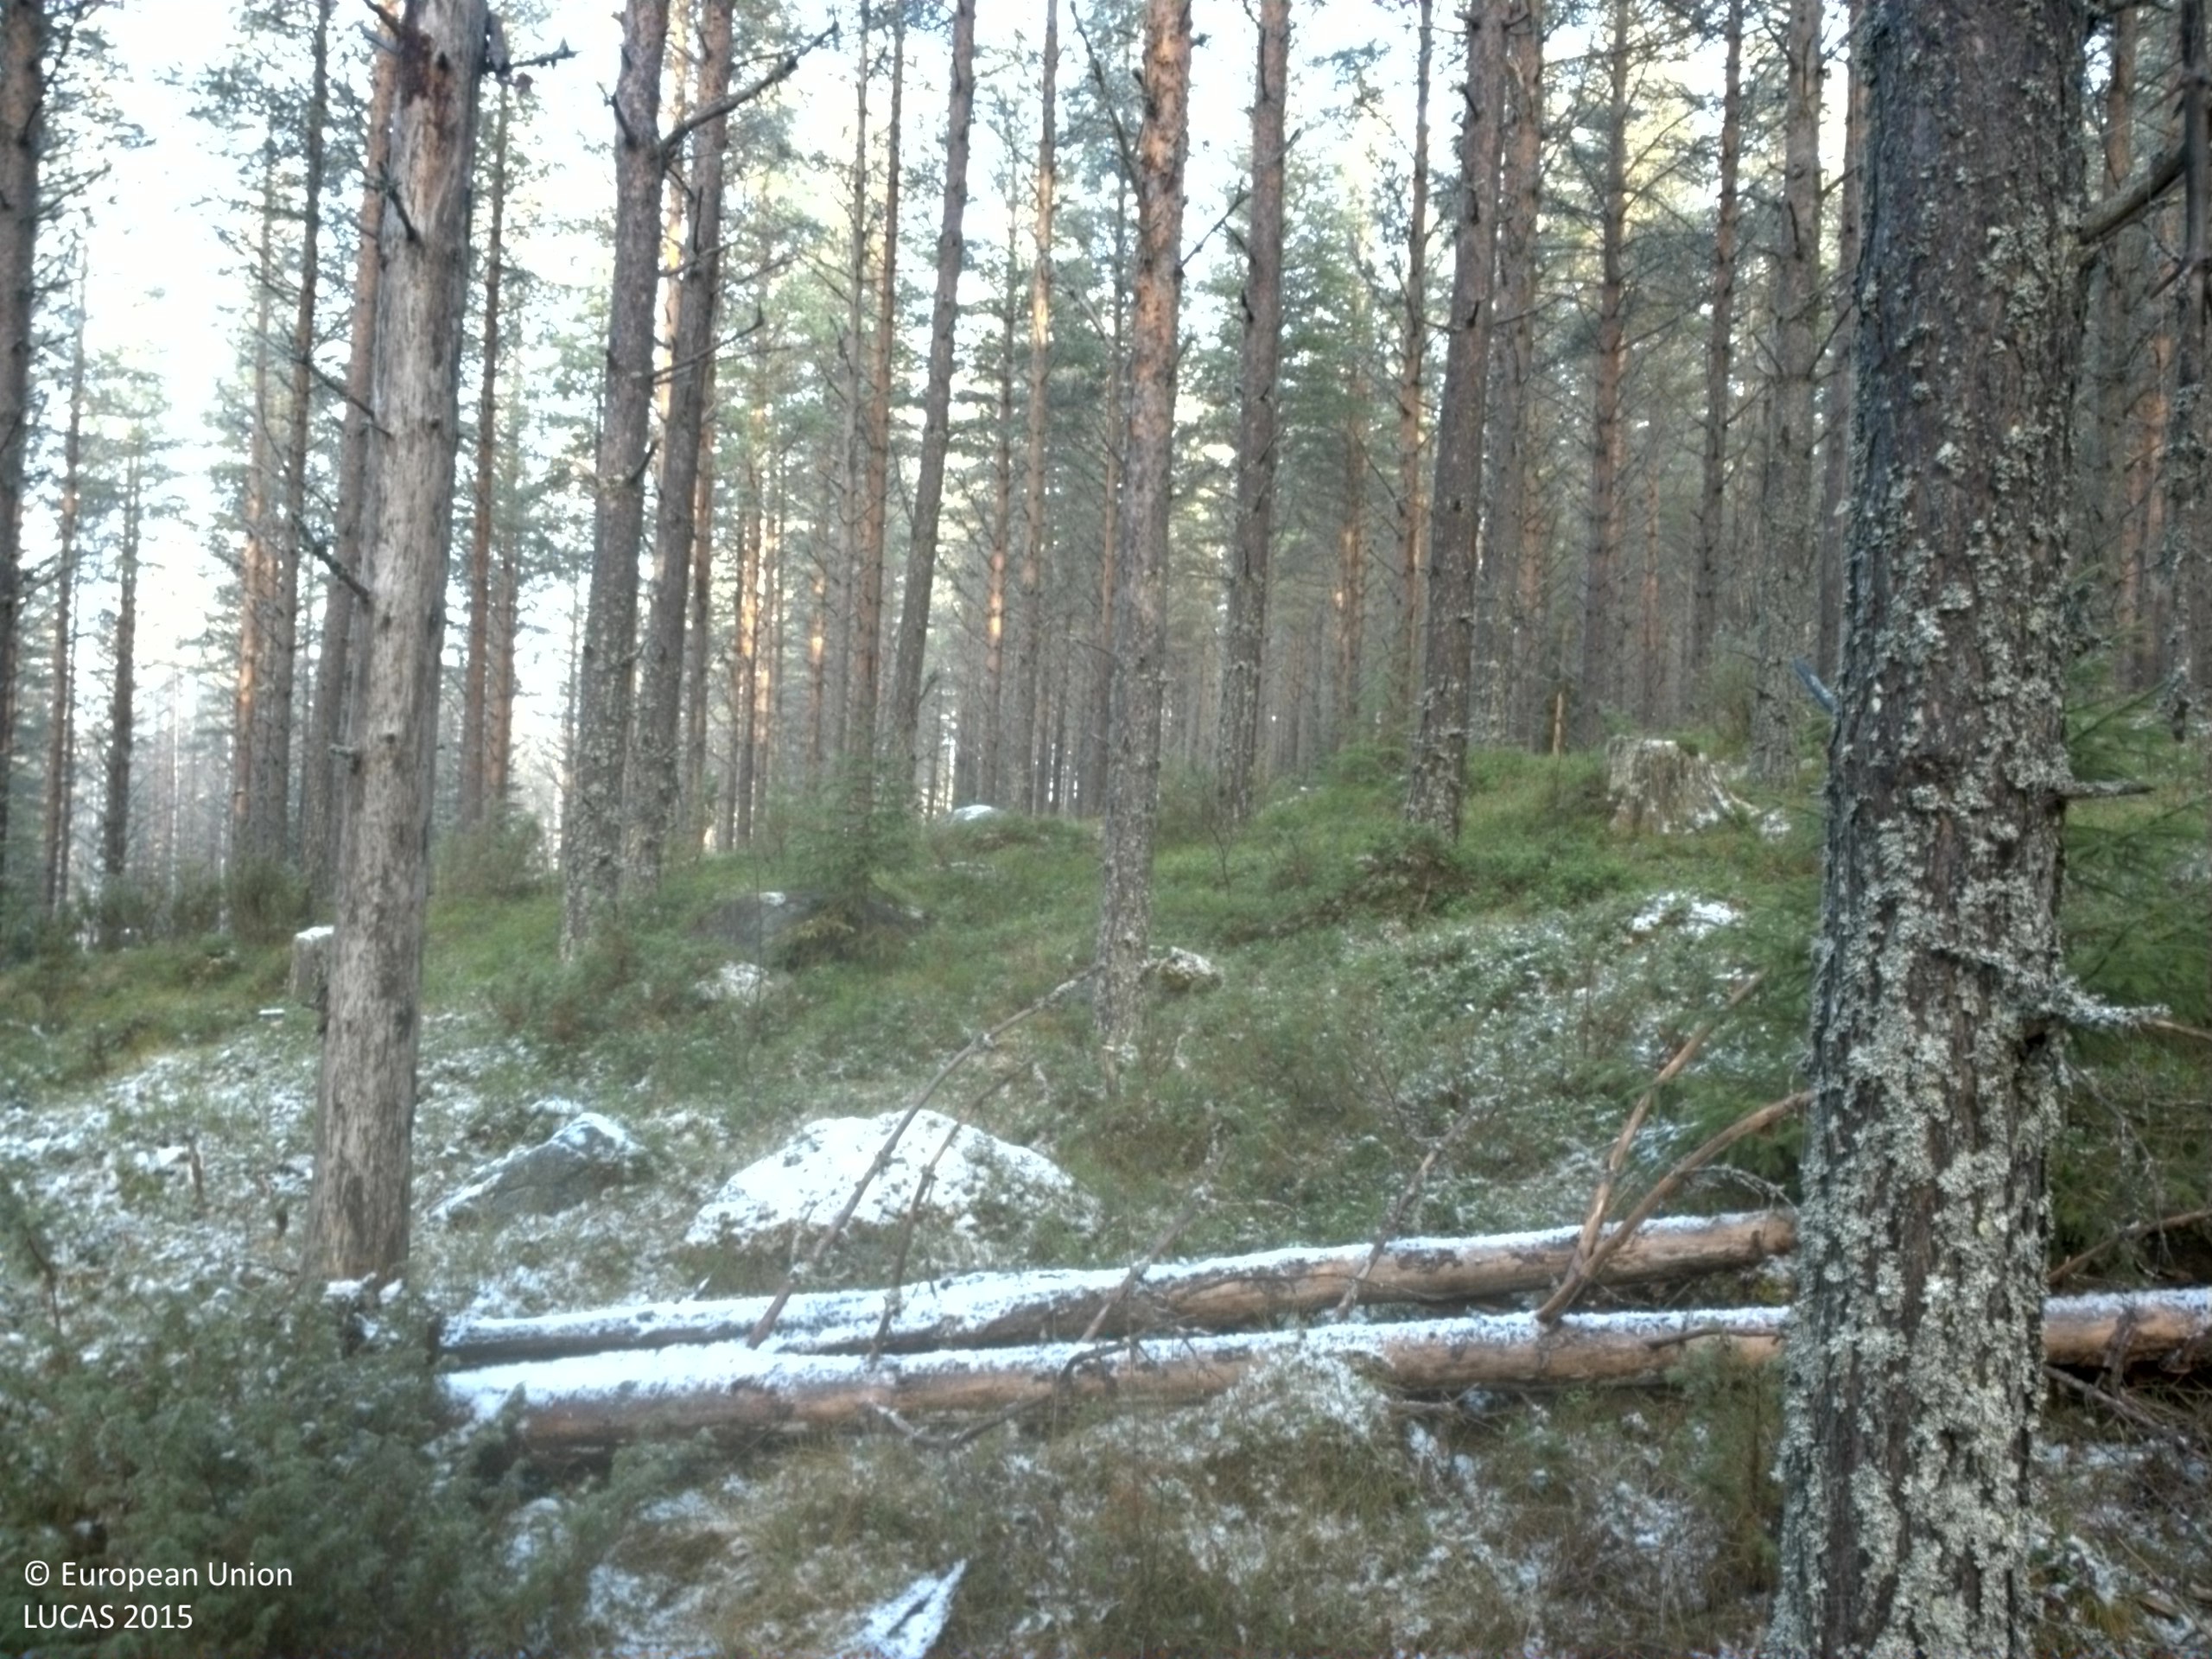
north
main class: Woodland
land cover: Pine dominated coniferous woodland
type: boreal forest
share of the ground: 25 - 50 %
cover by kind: coniferous forest trees 40 %, shrubs 35 %, lichens and mosses 15 %, broadleaved forest trees 5 %, herbaceous plants 5 %
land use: Forestry
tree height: > 5 m
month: November
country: SE
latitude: 63.6445
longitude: 15.6878
